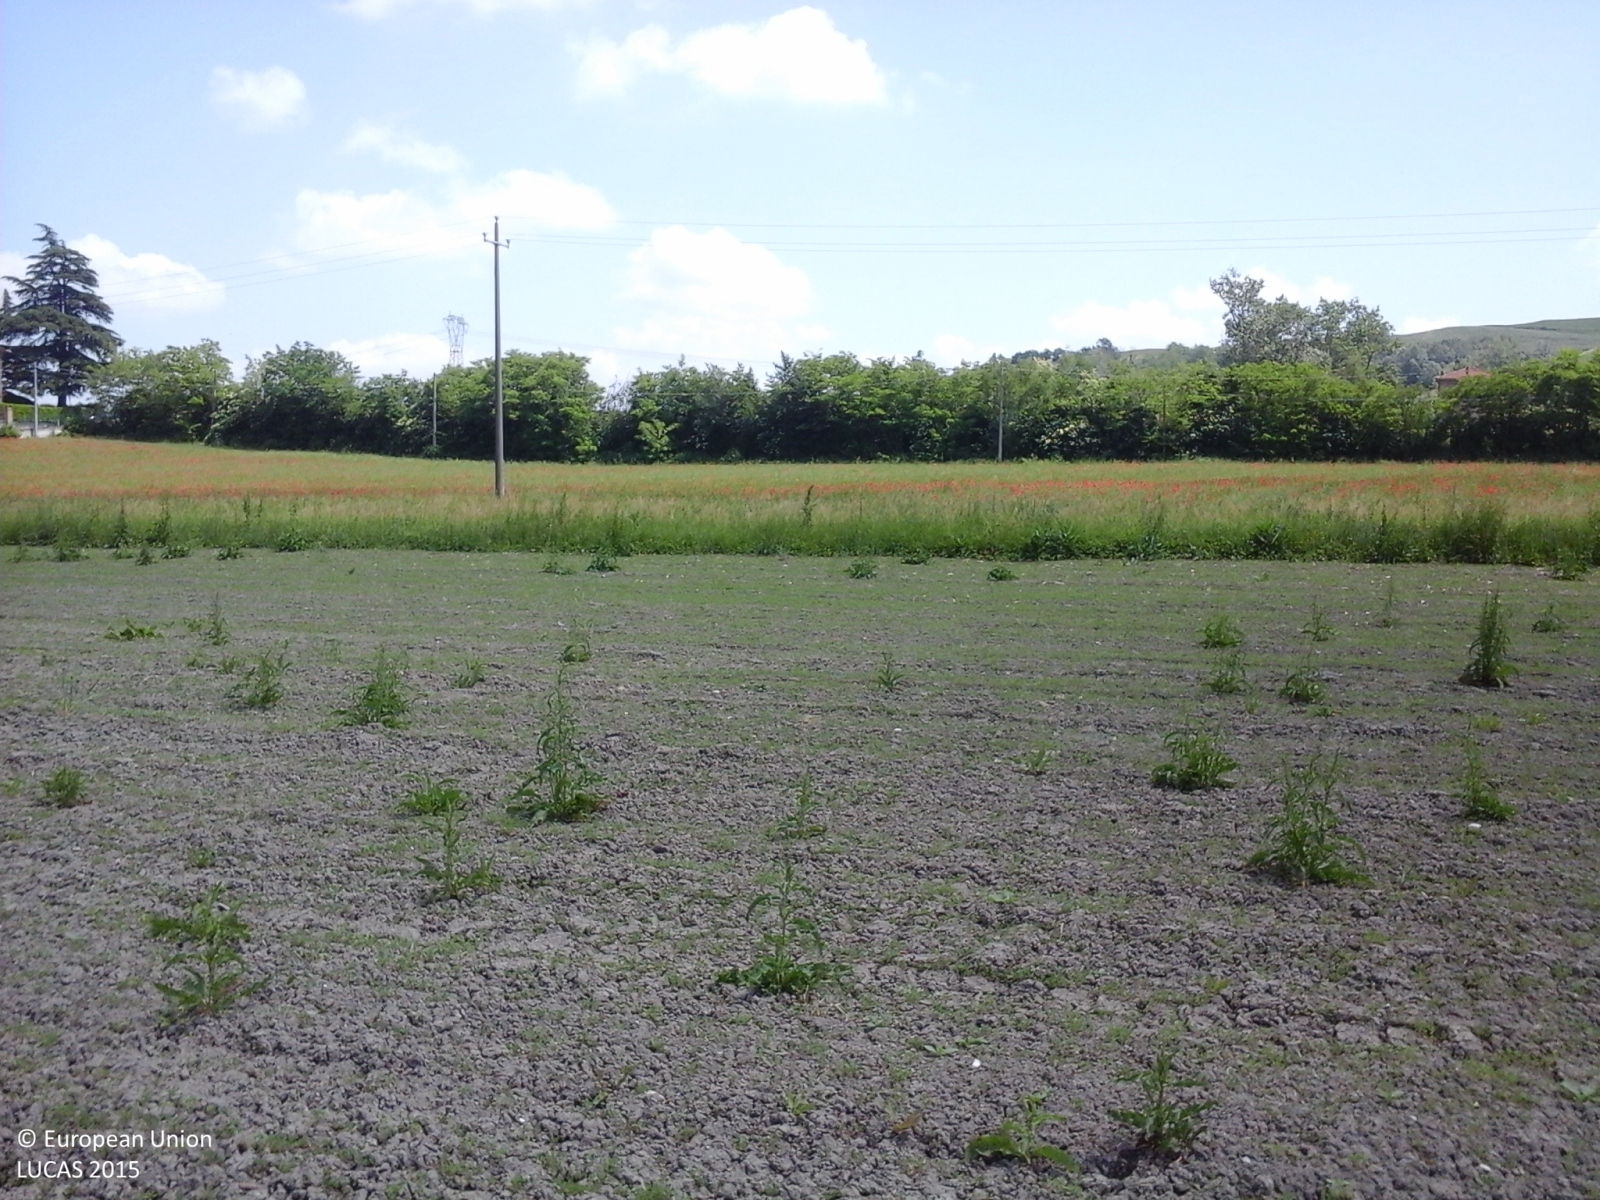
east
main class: Cropland
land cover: Lucerne
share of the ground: < 10 %
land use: Agriculture (excluding fallow land and kitchen gardens)
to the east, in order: Lucerne; Ditches and canals; Common wheat; Electric lines; Common wheat; Managed hedges; Grass margins; Paved roads, cycling and walking lanes; Grass margins; Ditches and canals; Barley; Grass margins; Ditches and canals; Grass margins
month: May
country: IT
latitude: 44.6570
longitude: 10.1888
